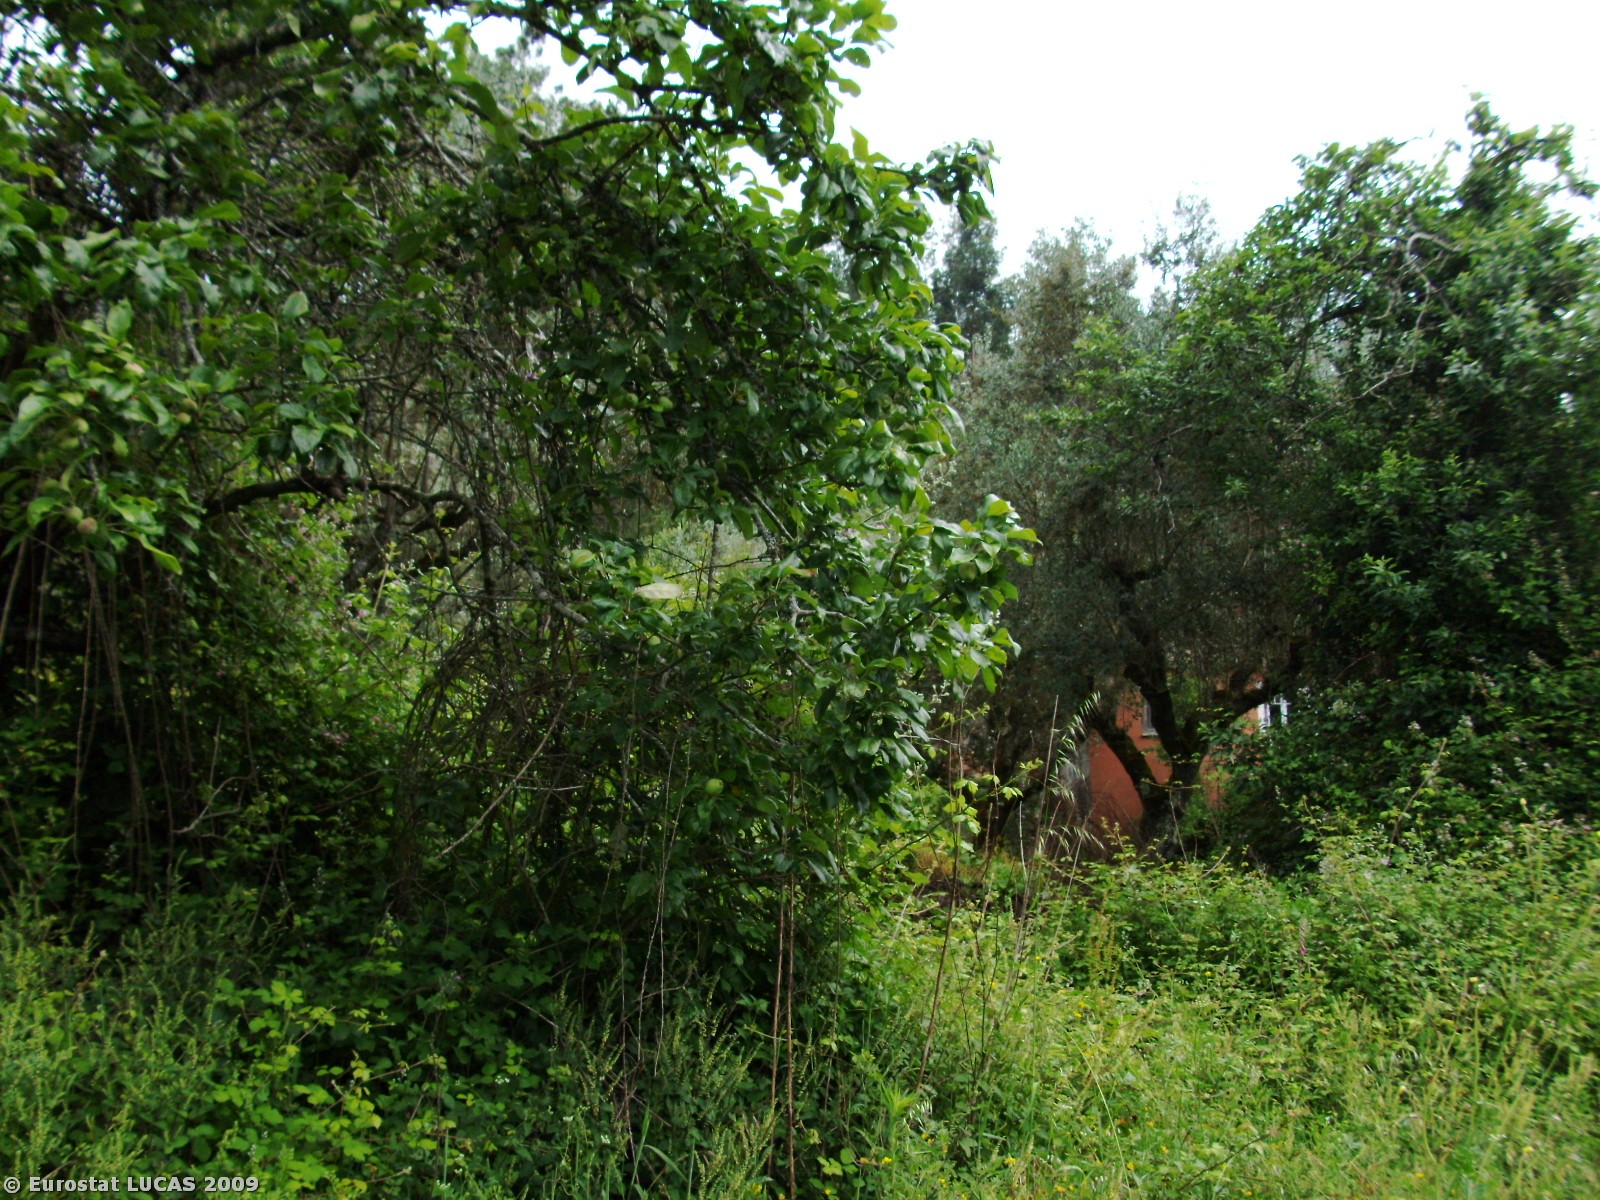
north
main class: Shrubland
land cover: Shrubland without tree cover
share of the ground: > 75 %
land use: Fallow land
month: June
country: PT
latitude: 39.8001
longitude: -8.3282
